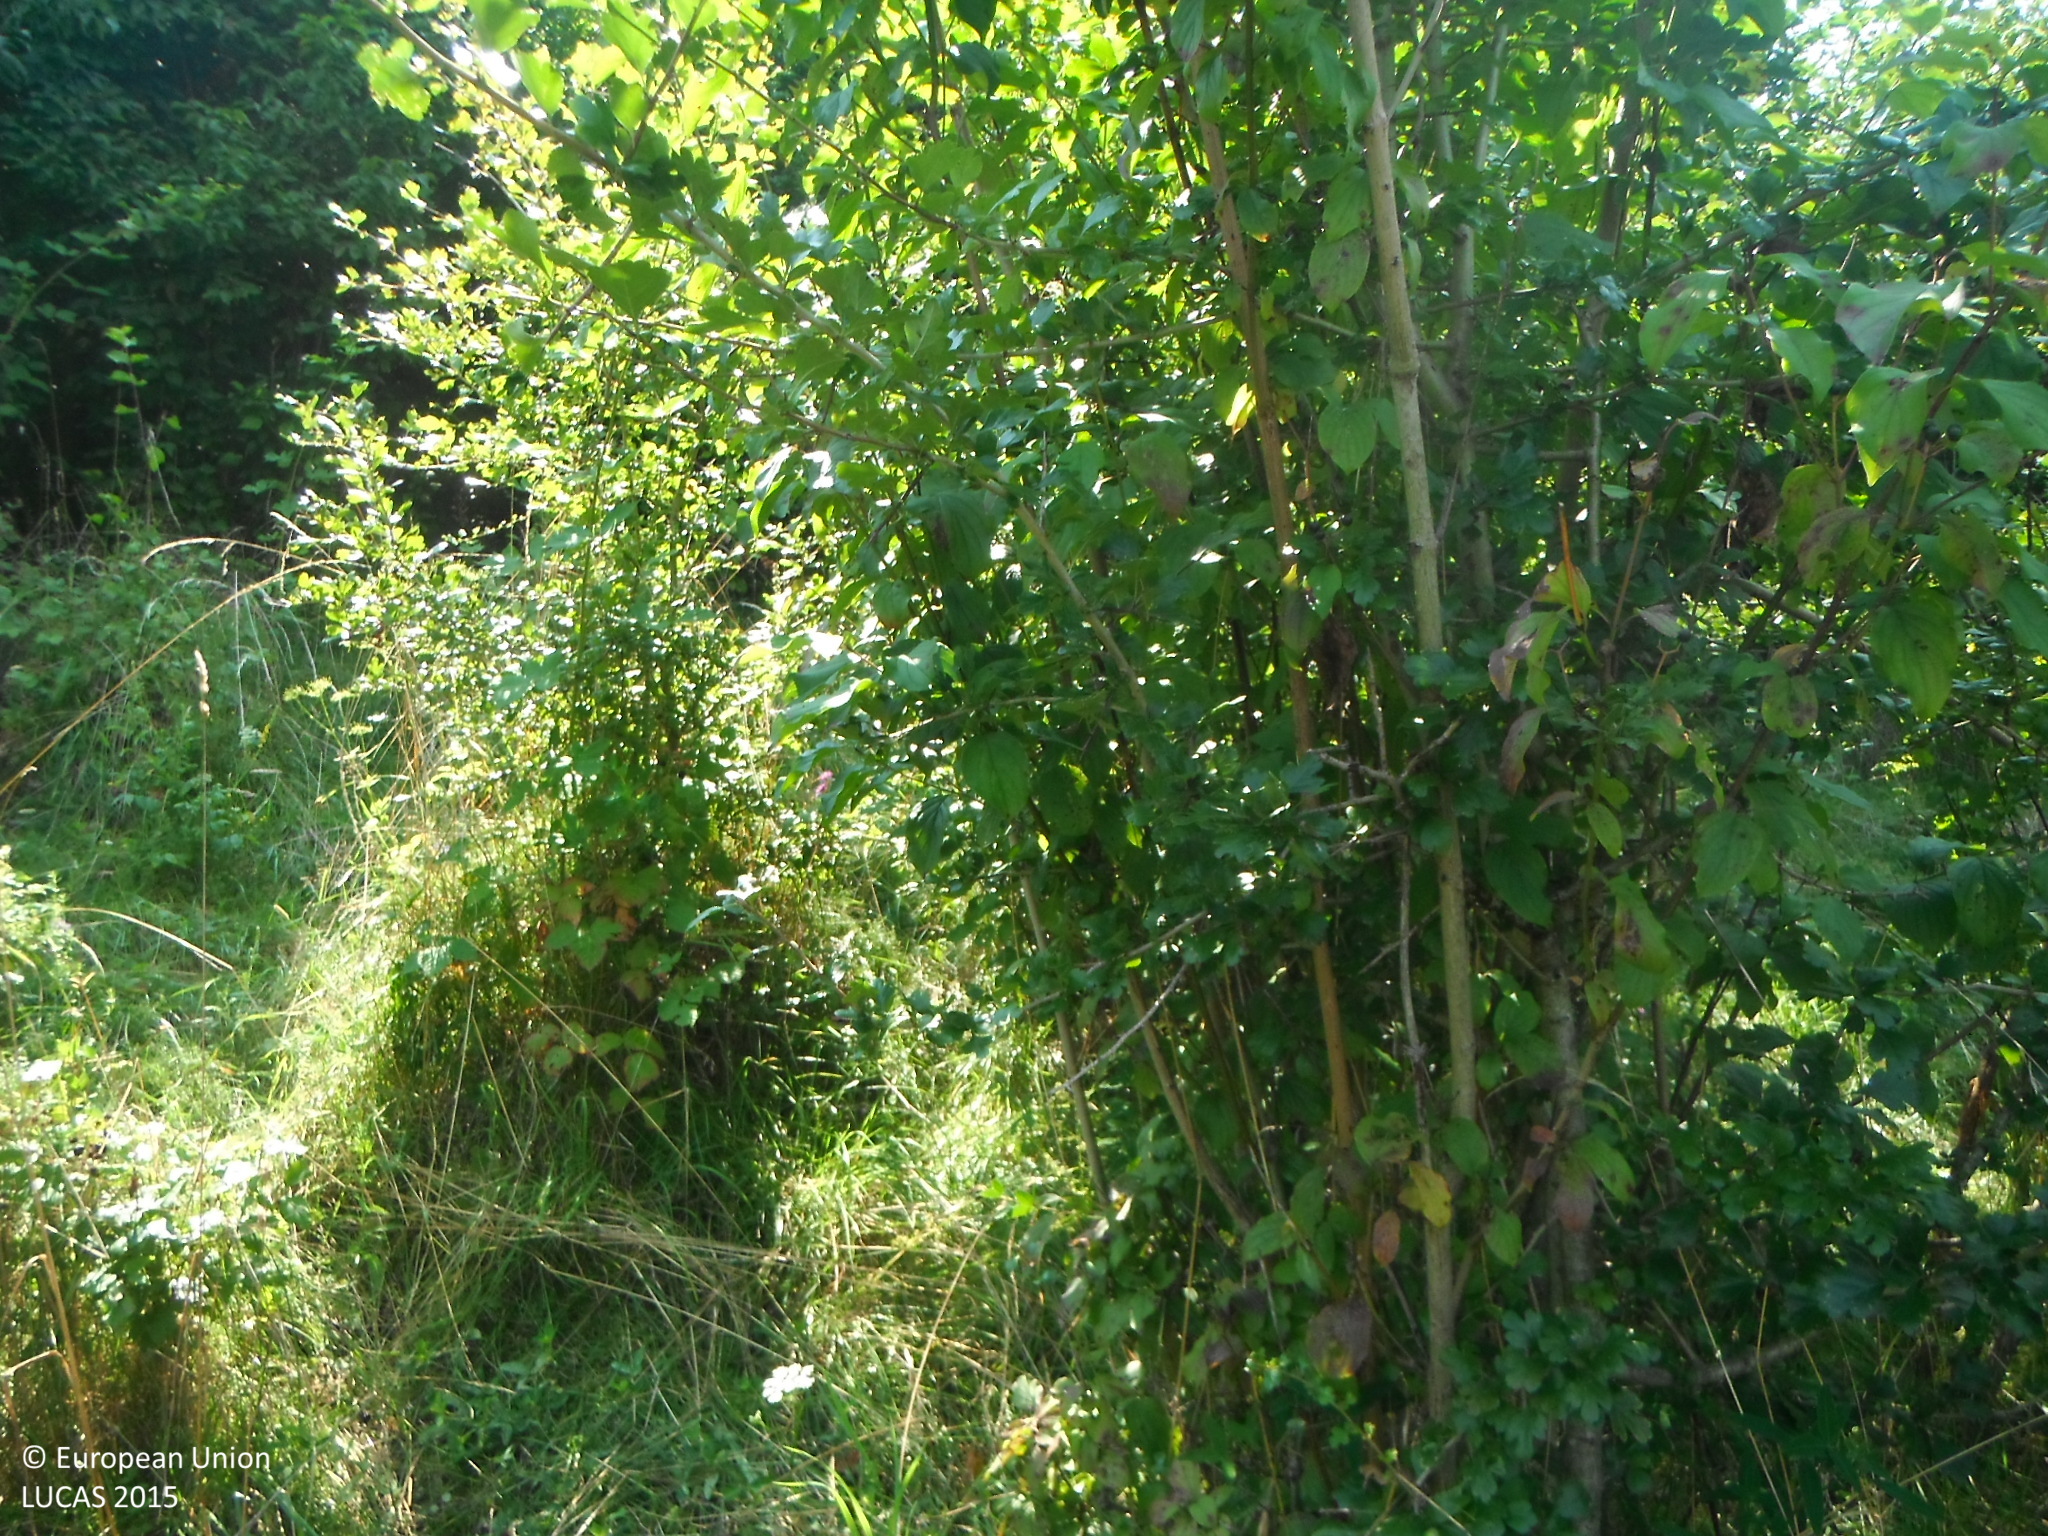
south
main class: Shrubland
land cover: Shrubland with sparse tree cover
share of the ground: > 75 %
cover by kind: shrubs 95 %, broadleaved forest trees 5 %
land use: Semi-natural and natural areas not in use
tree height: > 5 m
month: August
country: SK
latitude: 48.6257
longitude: 20.5230
